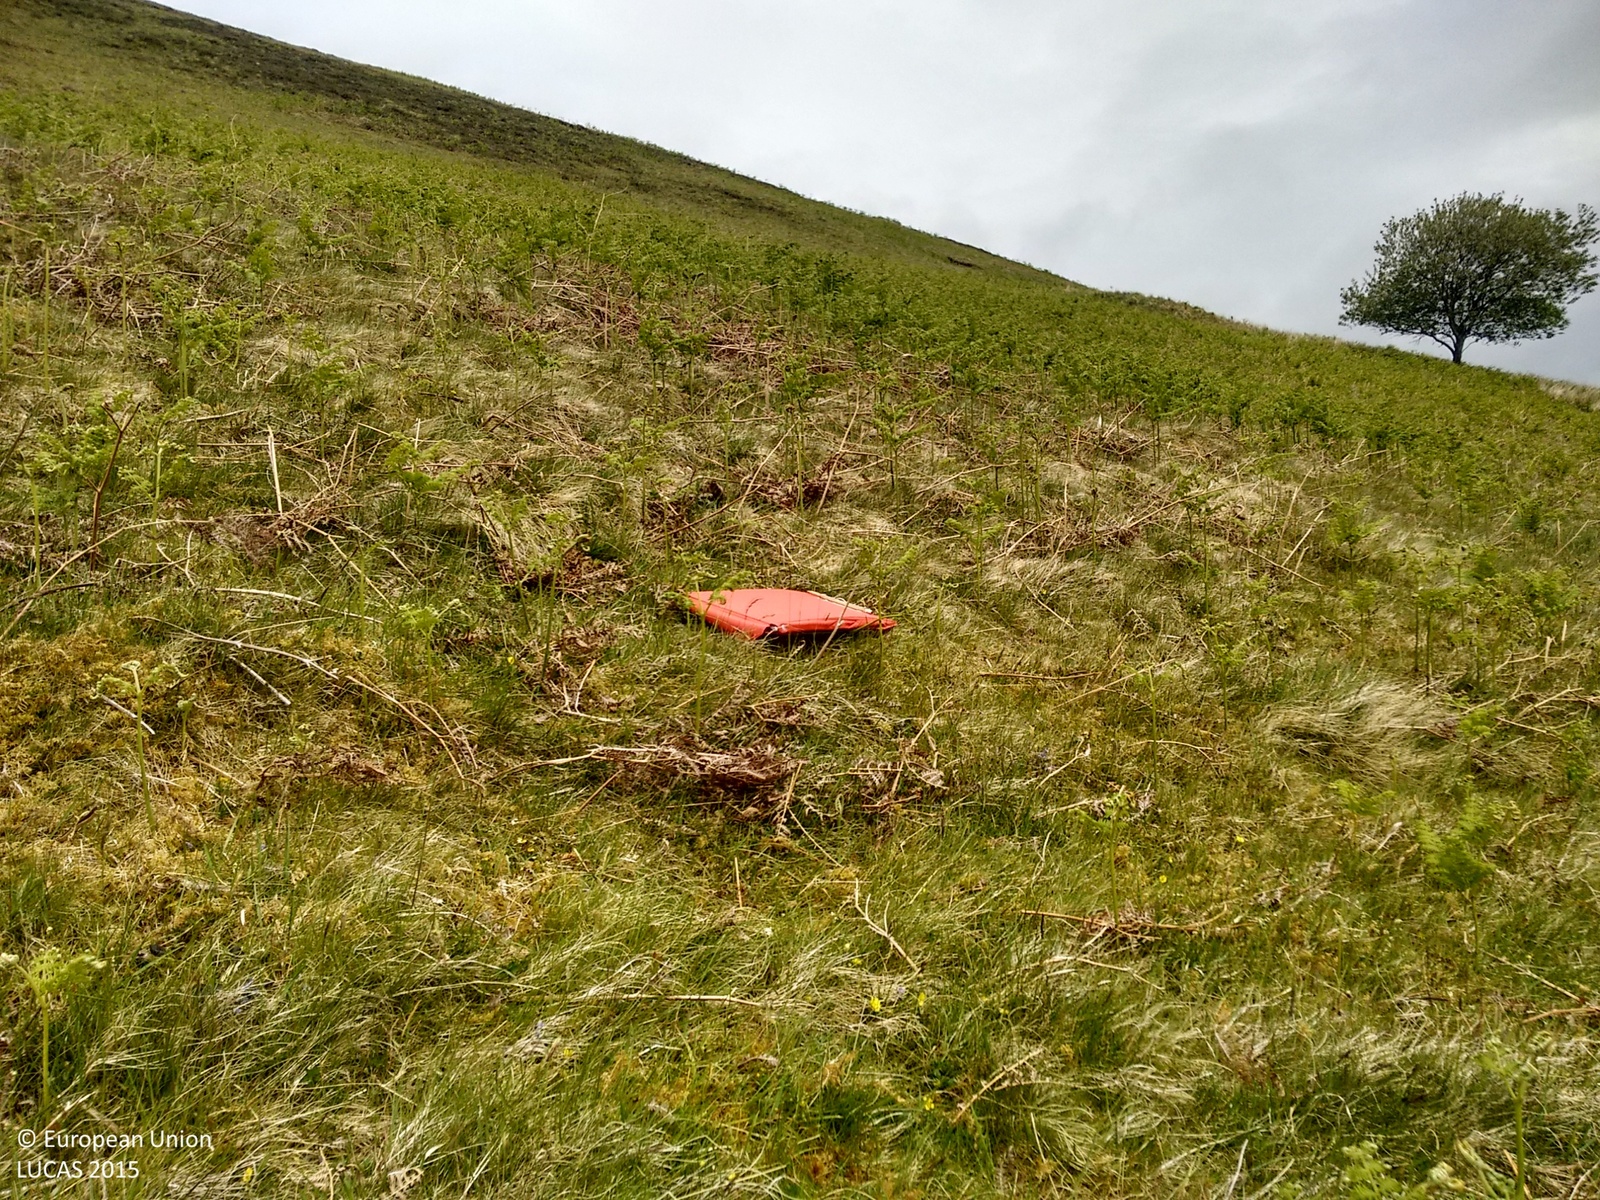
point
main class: Grassland
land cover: Grassland without tree/shrub cover
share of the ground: > 75 %
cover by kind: herbaceous plants 100 %
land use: Agriculture (excluding fallow land and kitchen gardens)
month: June
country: GB
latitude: 55.5461
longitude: -3.4709
